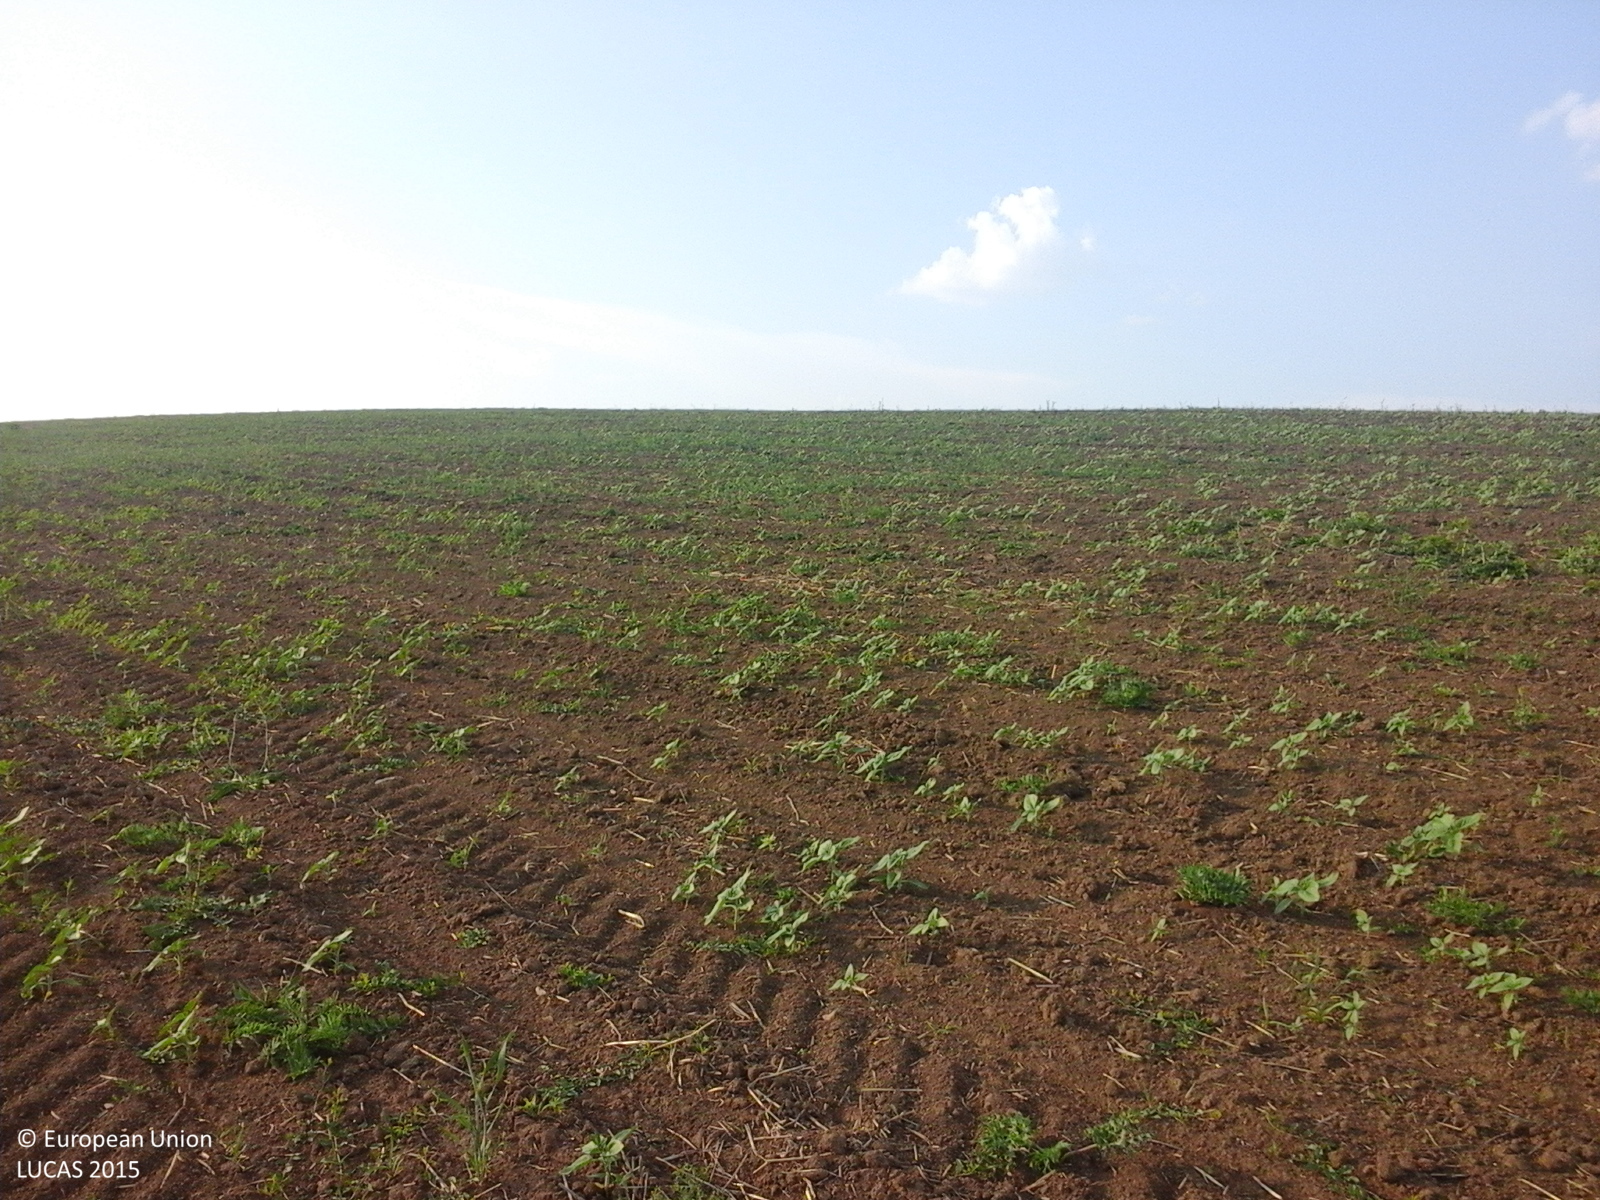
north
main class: Cropland
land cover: Sunflower
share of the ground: 10 - 25 %
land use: Agriculture (excluding fallow land and kitchen gardens)
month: June
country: RO
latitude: 46.3234
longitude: 27.2061
